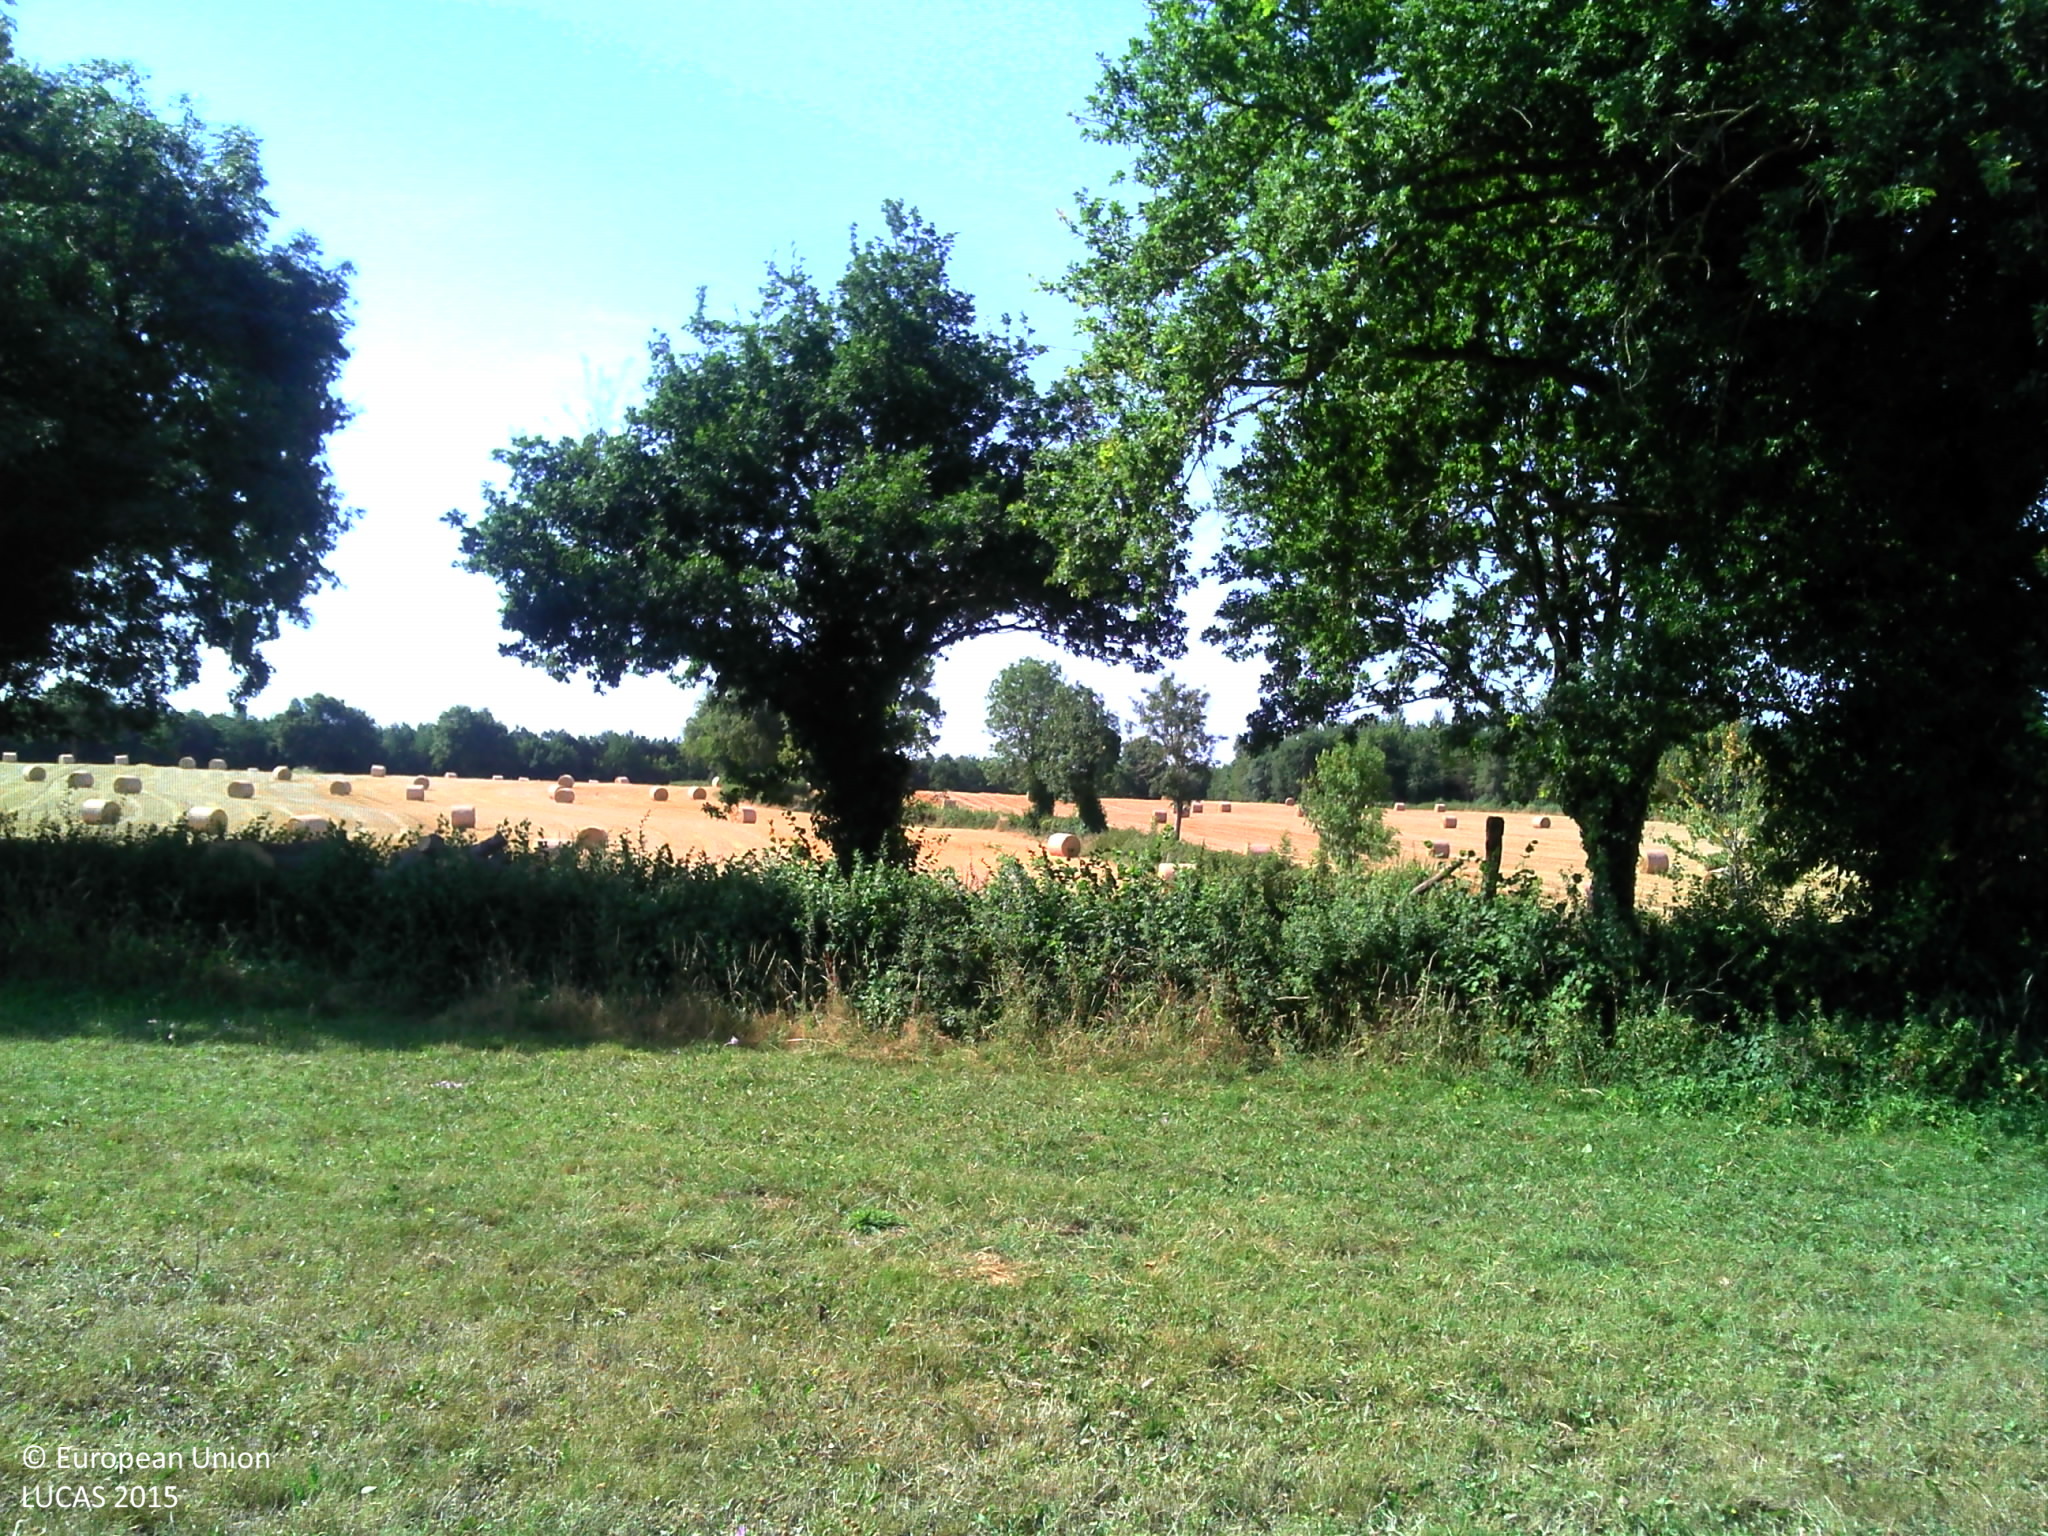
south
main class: Grassland
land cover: Grassland without tree/shrub cover
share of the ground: > 75 %
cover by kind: herbaceous plants 100 %
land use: Agriculture (excluding fallow land and kitchen gardens)
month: July
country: FR
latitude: 46.4655
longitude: 3.0044
